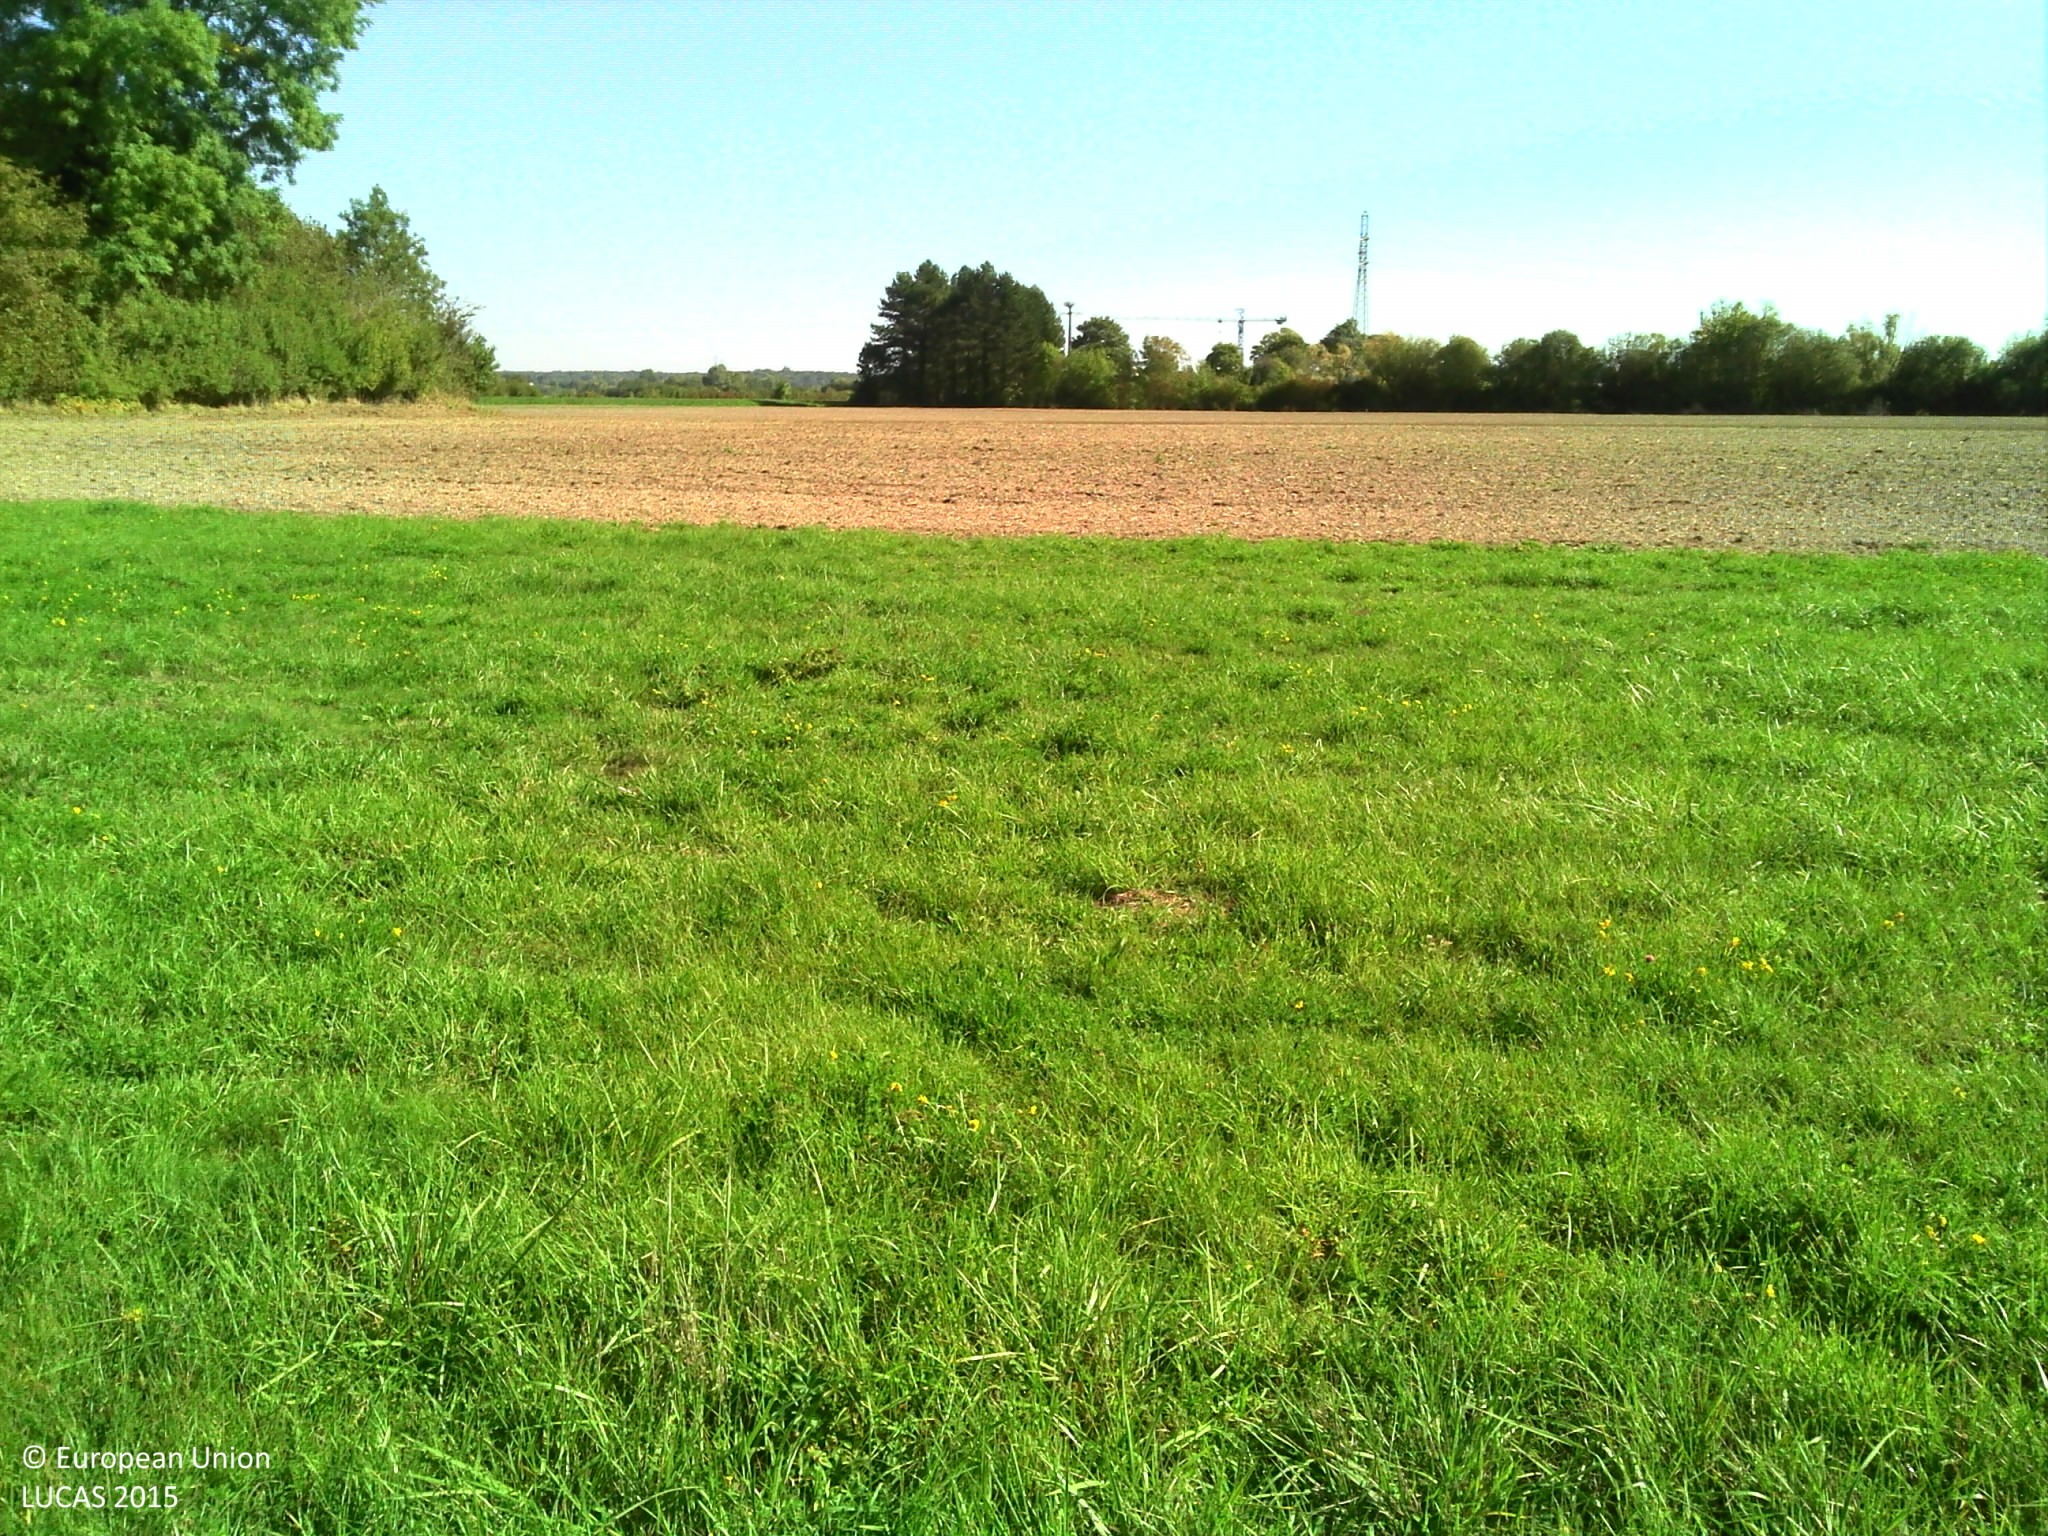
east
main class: Cropland
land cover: Temporary grasslands
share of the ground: > 75 %
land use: Agriculture (excluding fallow land and kitchen gardens)
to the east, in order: Temporary grasslands; Other bare soil; Temporary grasslands; Grass margins; Tracks; Grass margins; Paved roads, cycling and walking lanes; Grass margins; Other fibre and oleaginous crops
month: September
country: FR
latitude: 48.1791
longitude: 4.2004
